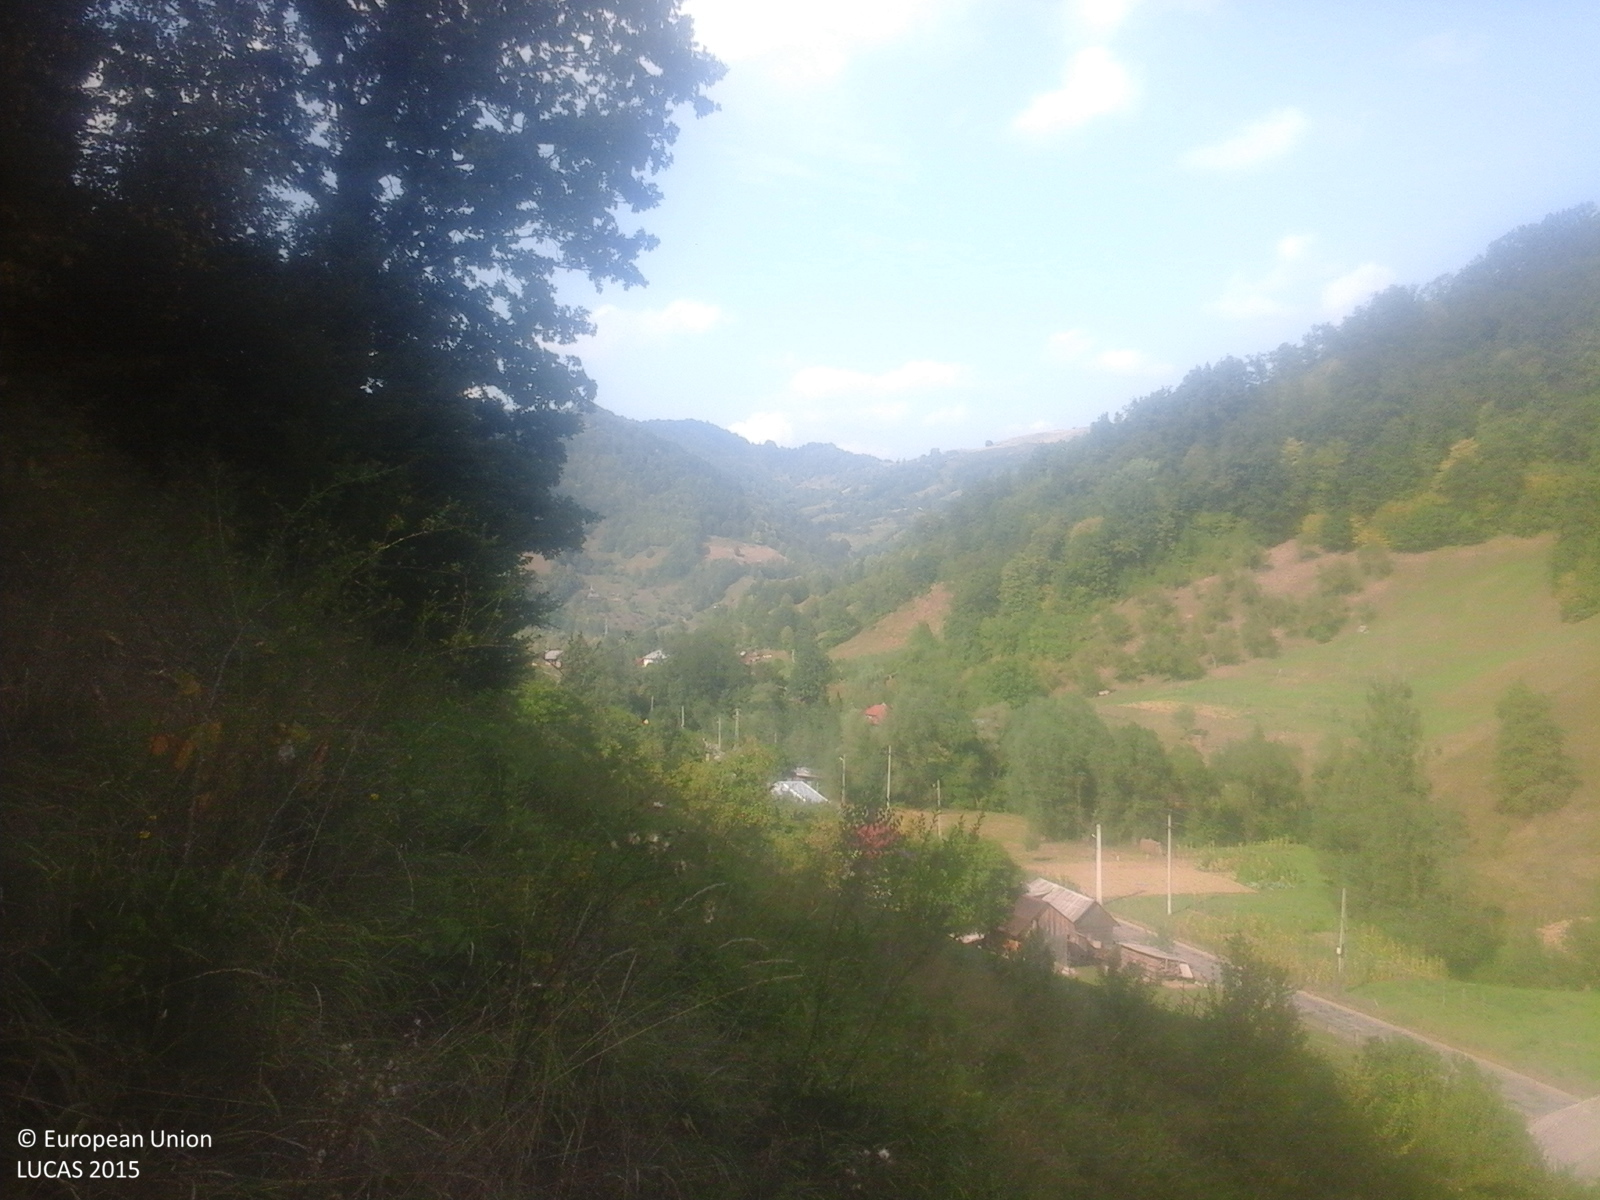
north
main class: Grassland
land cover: Grassland with sparse tree/shrub cover
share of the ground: > 75 %
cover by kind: herbaceous plants 85 %, shrubs 10 %, broadleaved forest trees 5 %
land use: Agriculture (excluding fallow land and kitchen gardens)
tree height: < 5 m
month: September
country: RO
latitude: 47.7217
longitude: 24.3154
